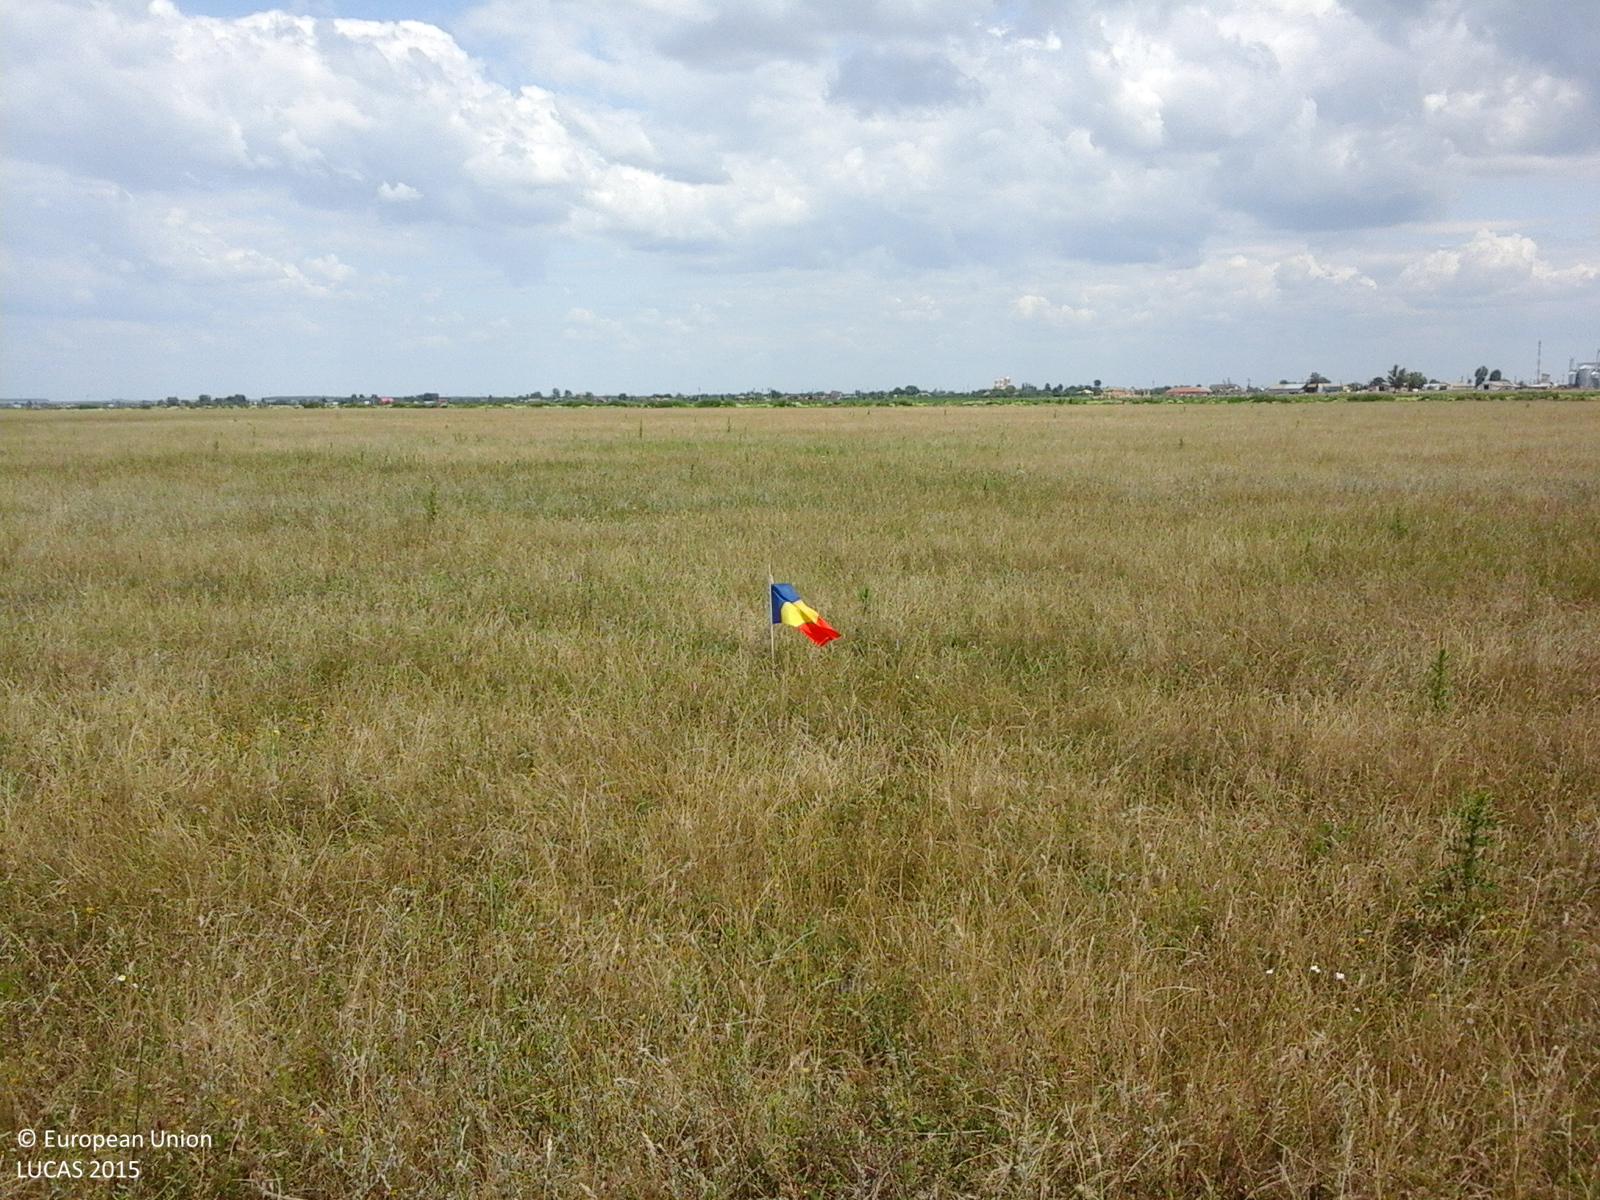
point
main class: Grassland
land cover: Grassland without tree/shrub cover
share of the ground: > 75 %
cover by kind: herbaceous plants 100 %
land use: Agriculture (excluding fallow land and kitchen gardens)
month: July
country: RO
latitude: 44.2613
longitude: 24.7415
